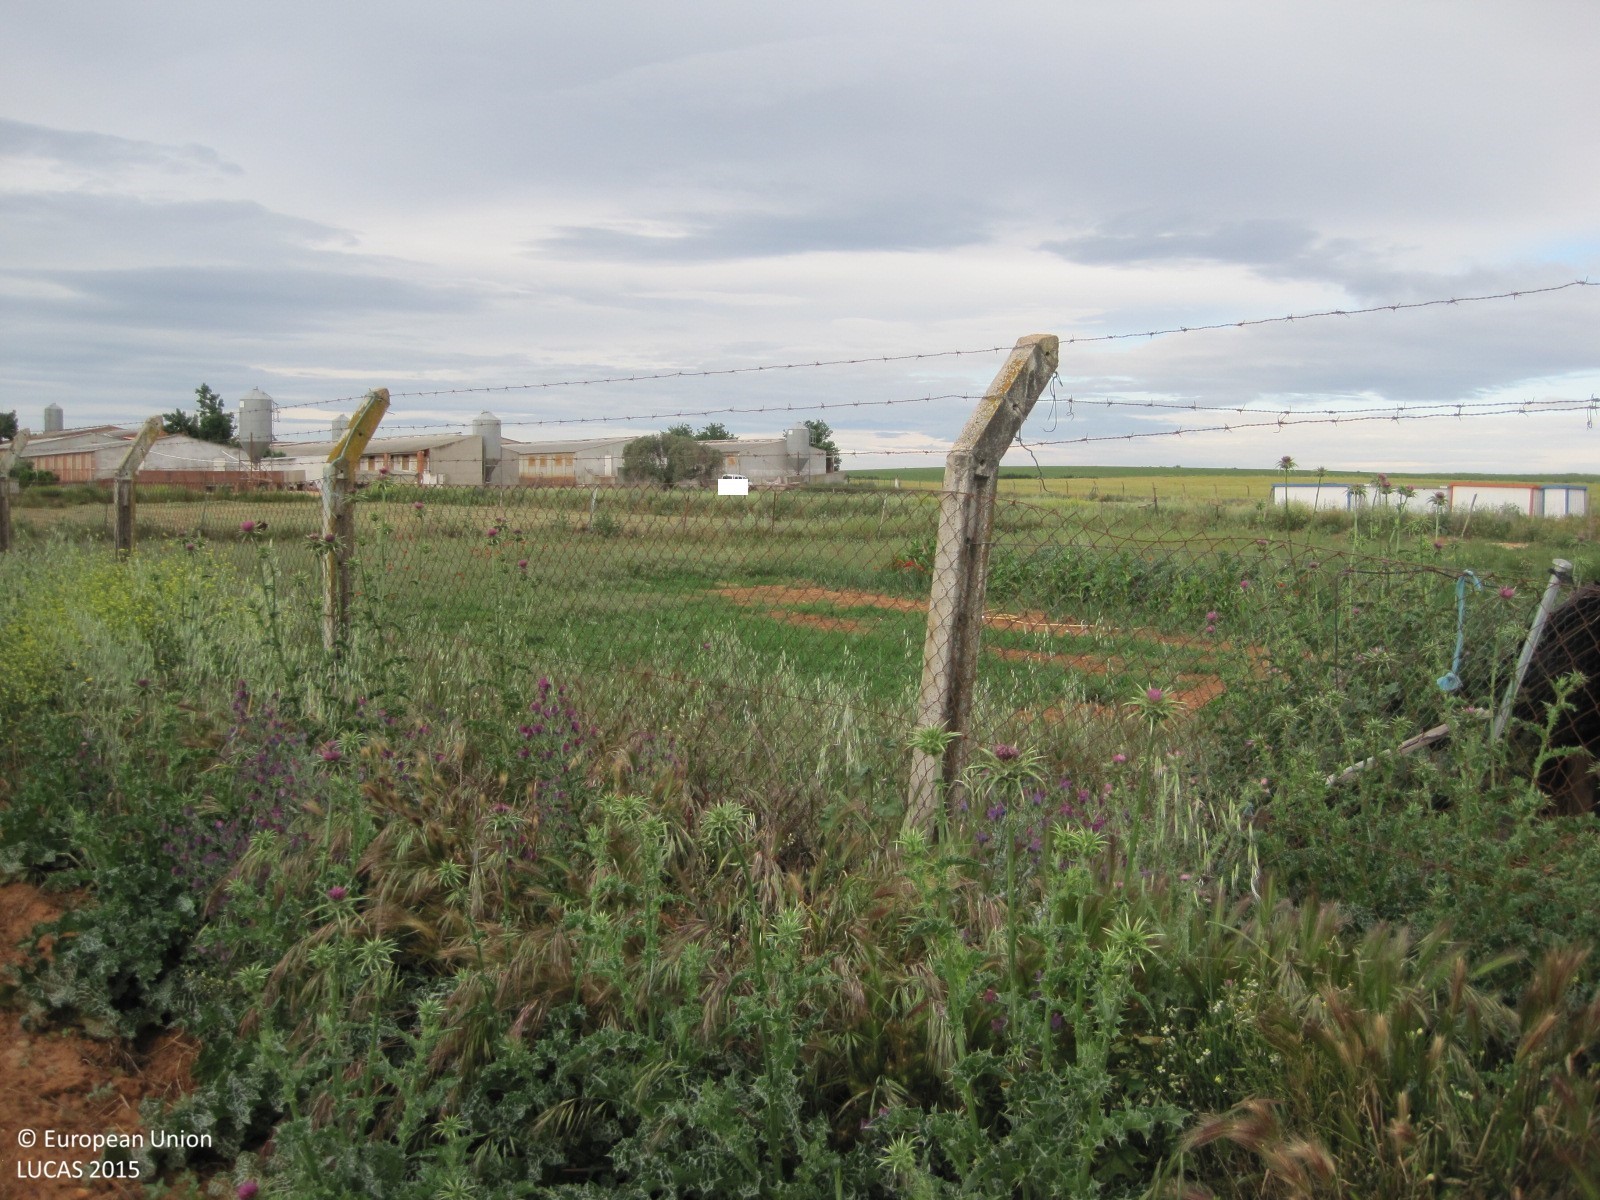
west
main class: Cropland
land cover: Barley
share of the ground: > 75 %
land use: Agriculture (excluding fallow land and kitchen gardens)
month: May
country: ES
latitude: 39.8879
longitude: -4.6974
